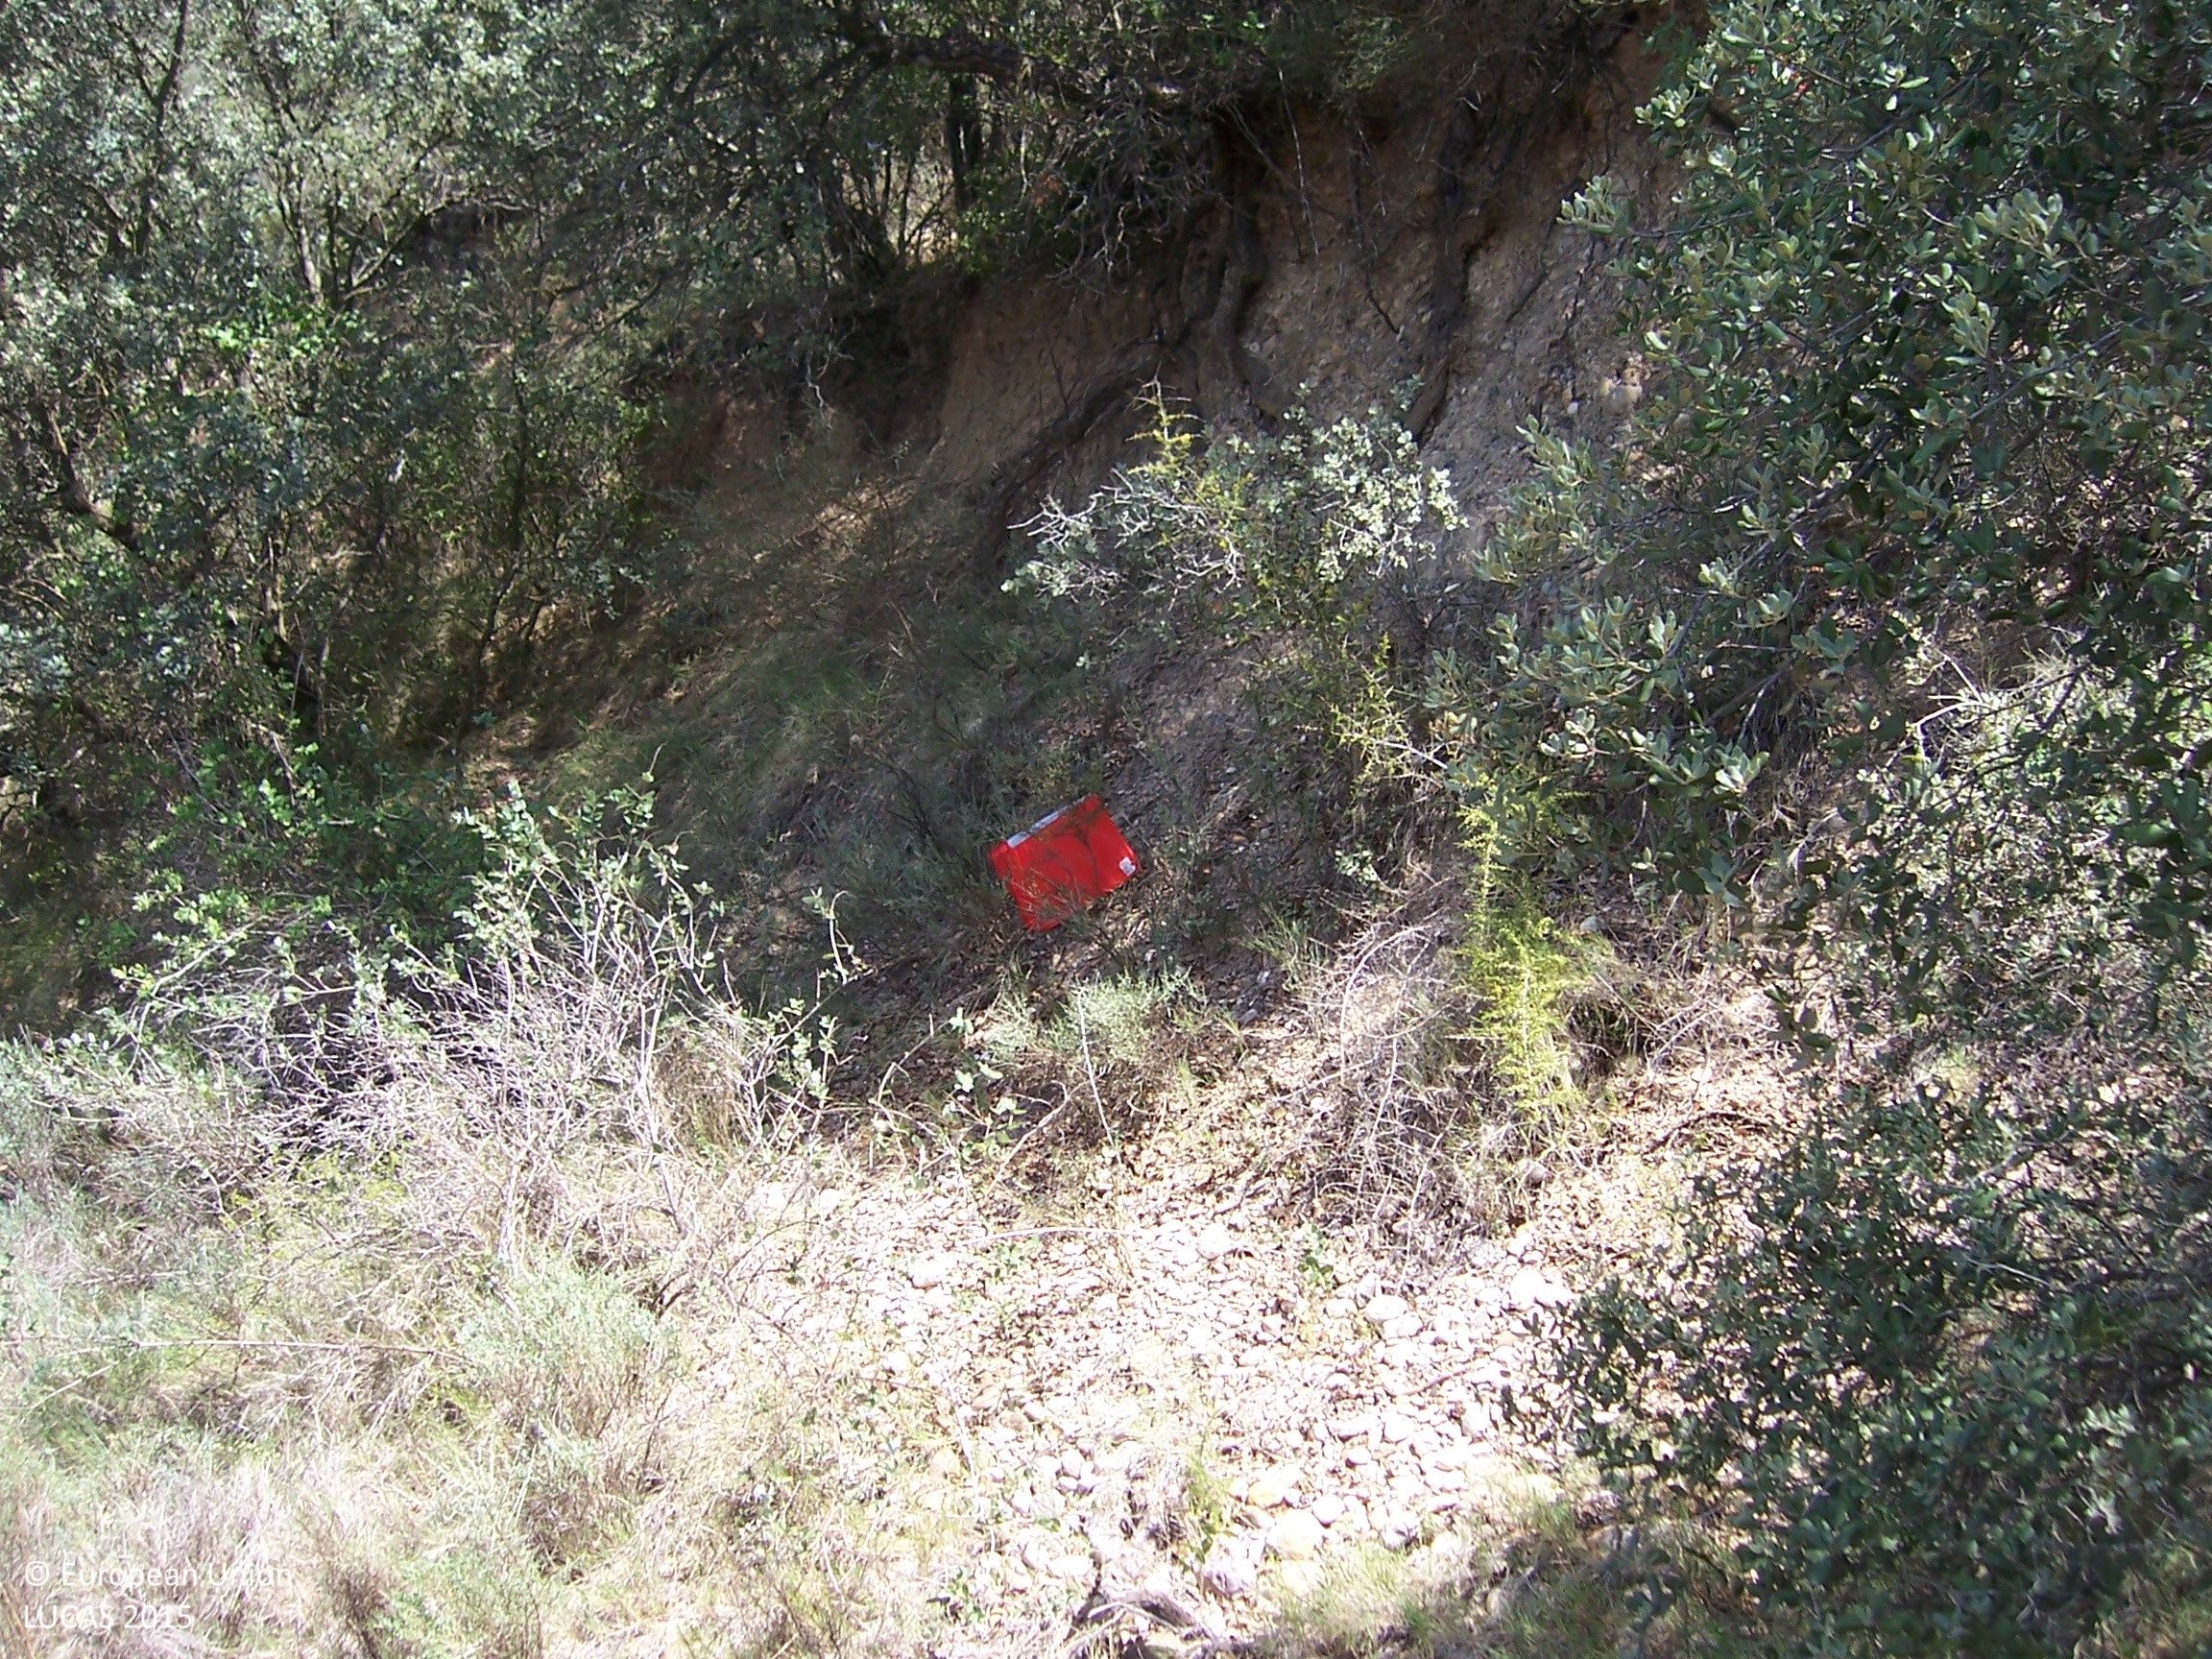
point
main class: Woodland
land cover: Broadleaved woodland
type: broadleaved evergreen forest
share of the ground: > 75 %
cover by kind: broadleaved forest trees 50 %, herbaceous plants 30 %, shrubs 10 %, unconsolidated bare surface 10 %
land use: Semi-natural and natural areas not in use
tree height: > 5 m
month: August
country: ES
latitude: 42.1383
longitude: 0.1689
